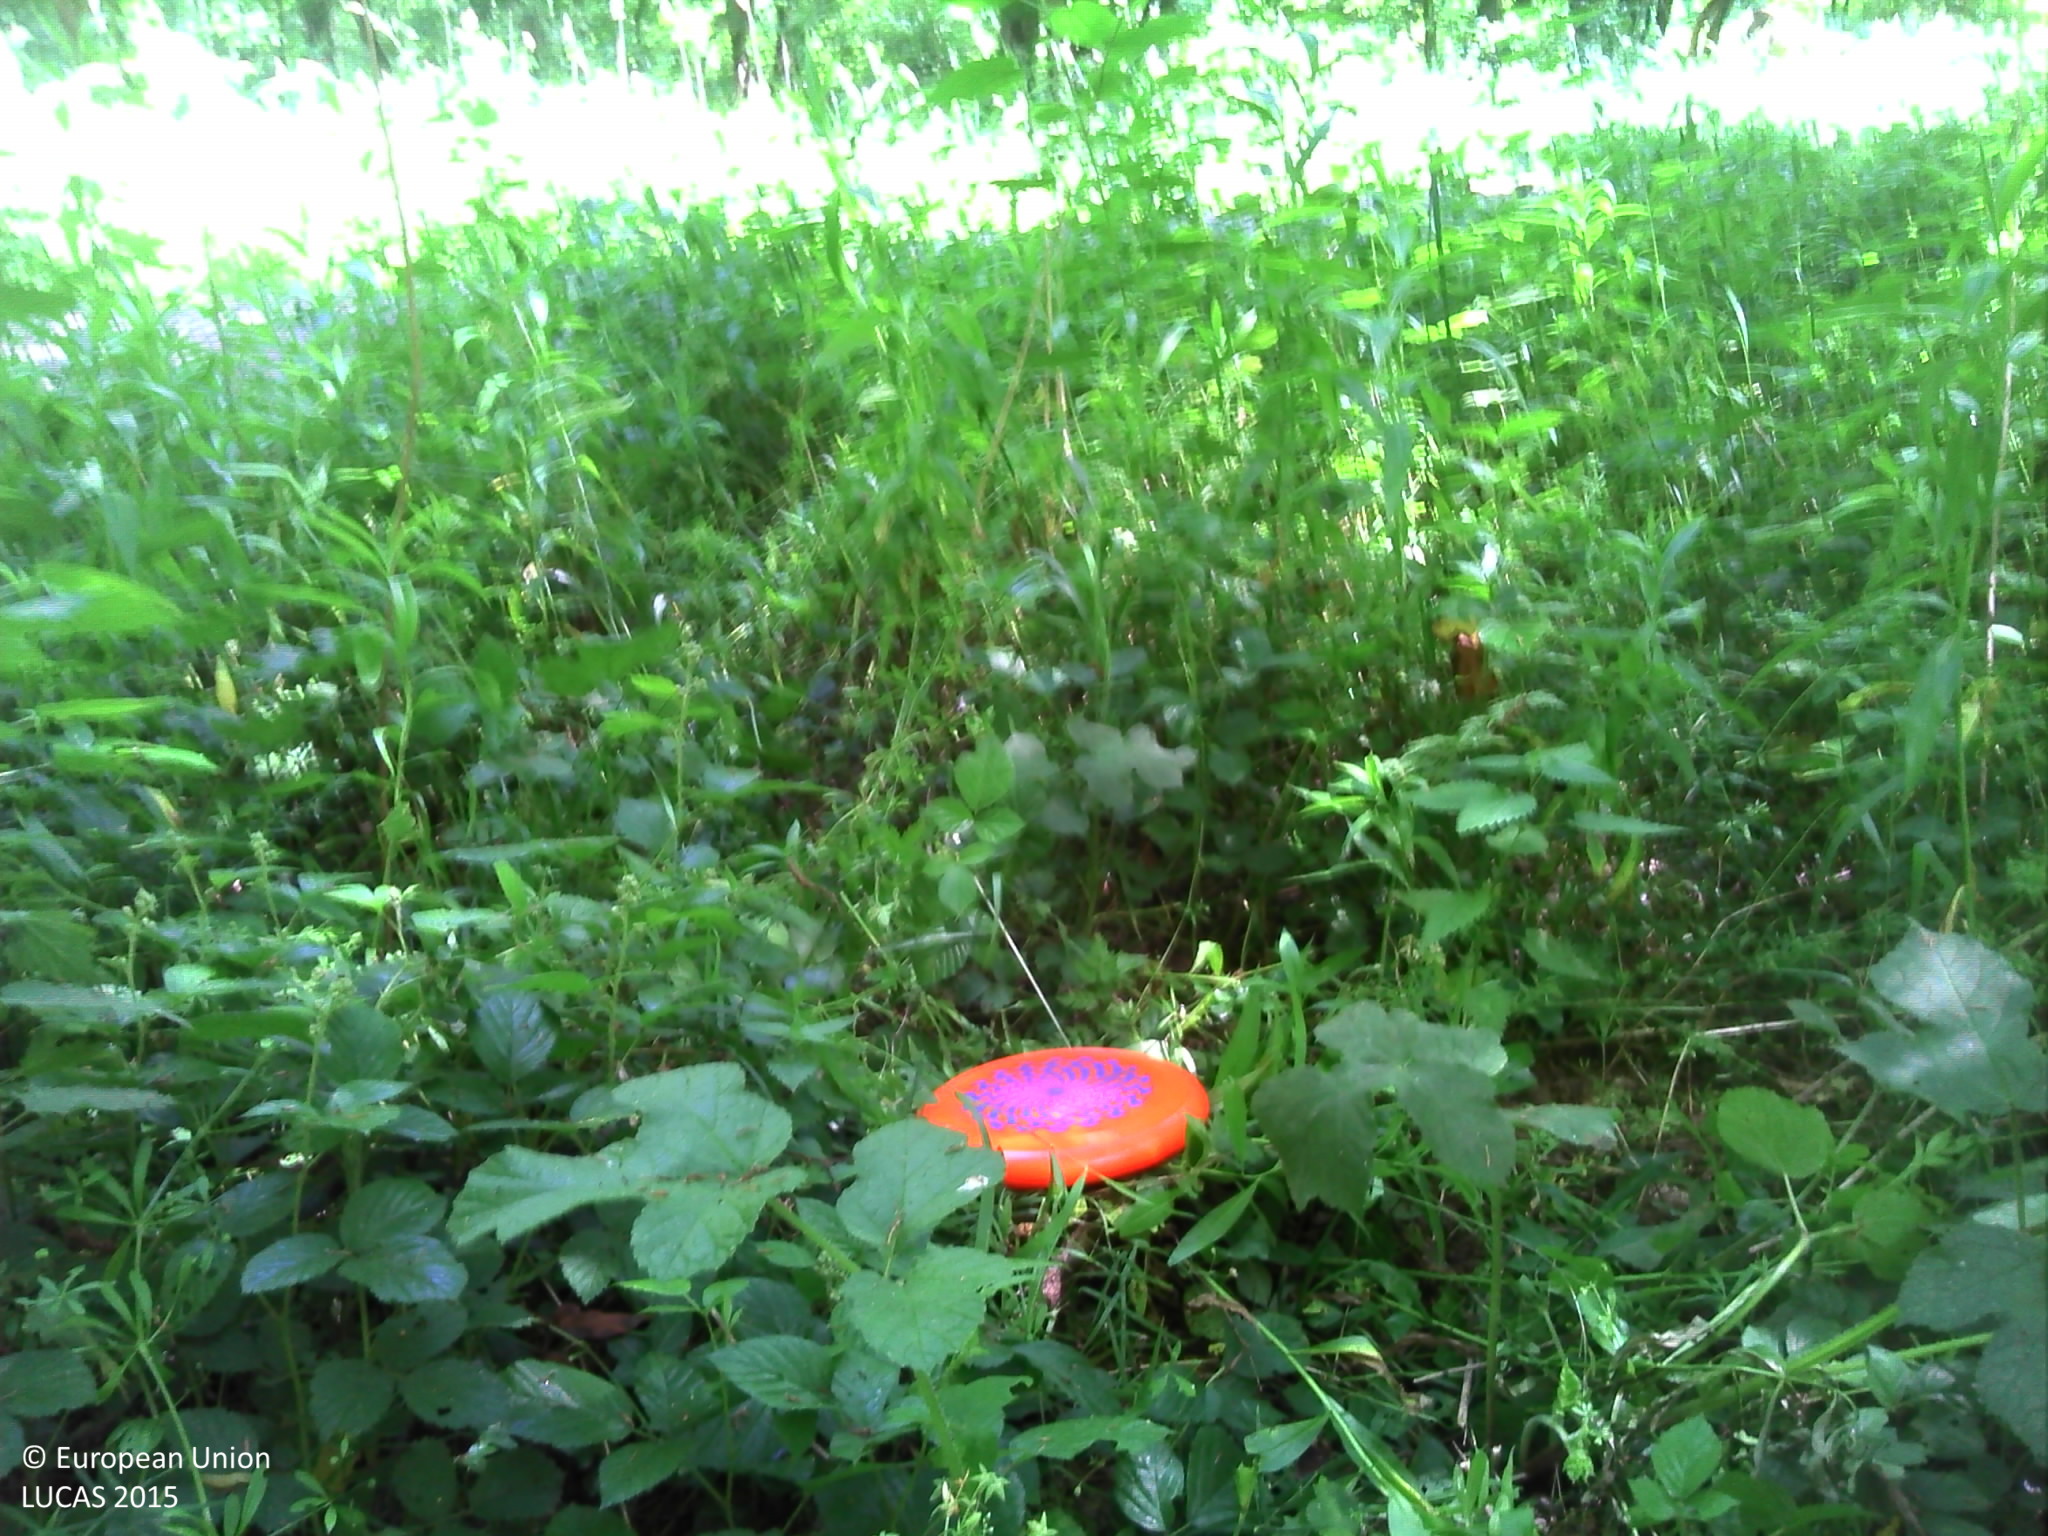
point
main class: Woodland
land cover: Broadleaved woodland
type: mesophytic deciduous forest
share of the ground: > 75 %
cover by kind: broadleaved forest trees 90 %, herbaceous plants 10 %
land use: Forestry
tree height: > 5 m
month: June
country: FR
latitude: 47.6727
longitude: 7.4843
